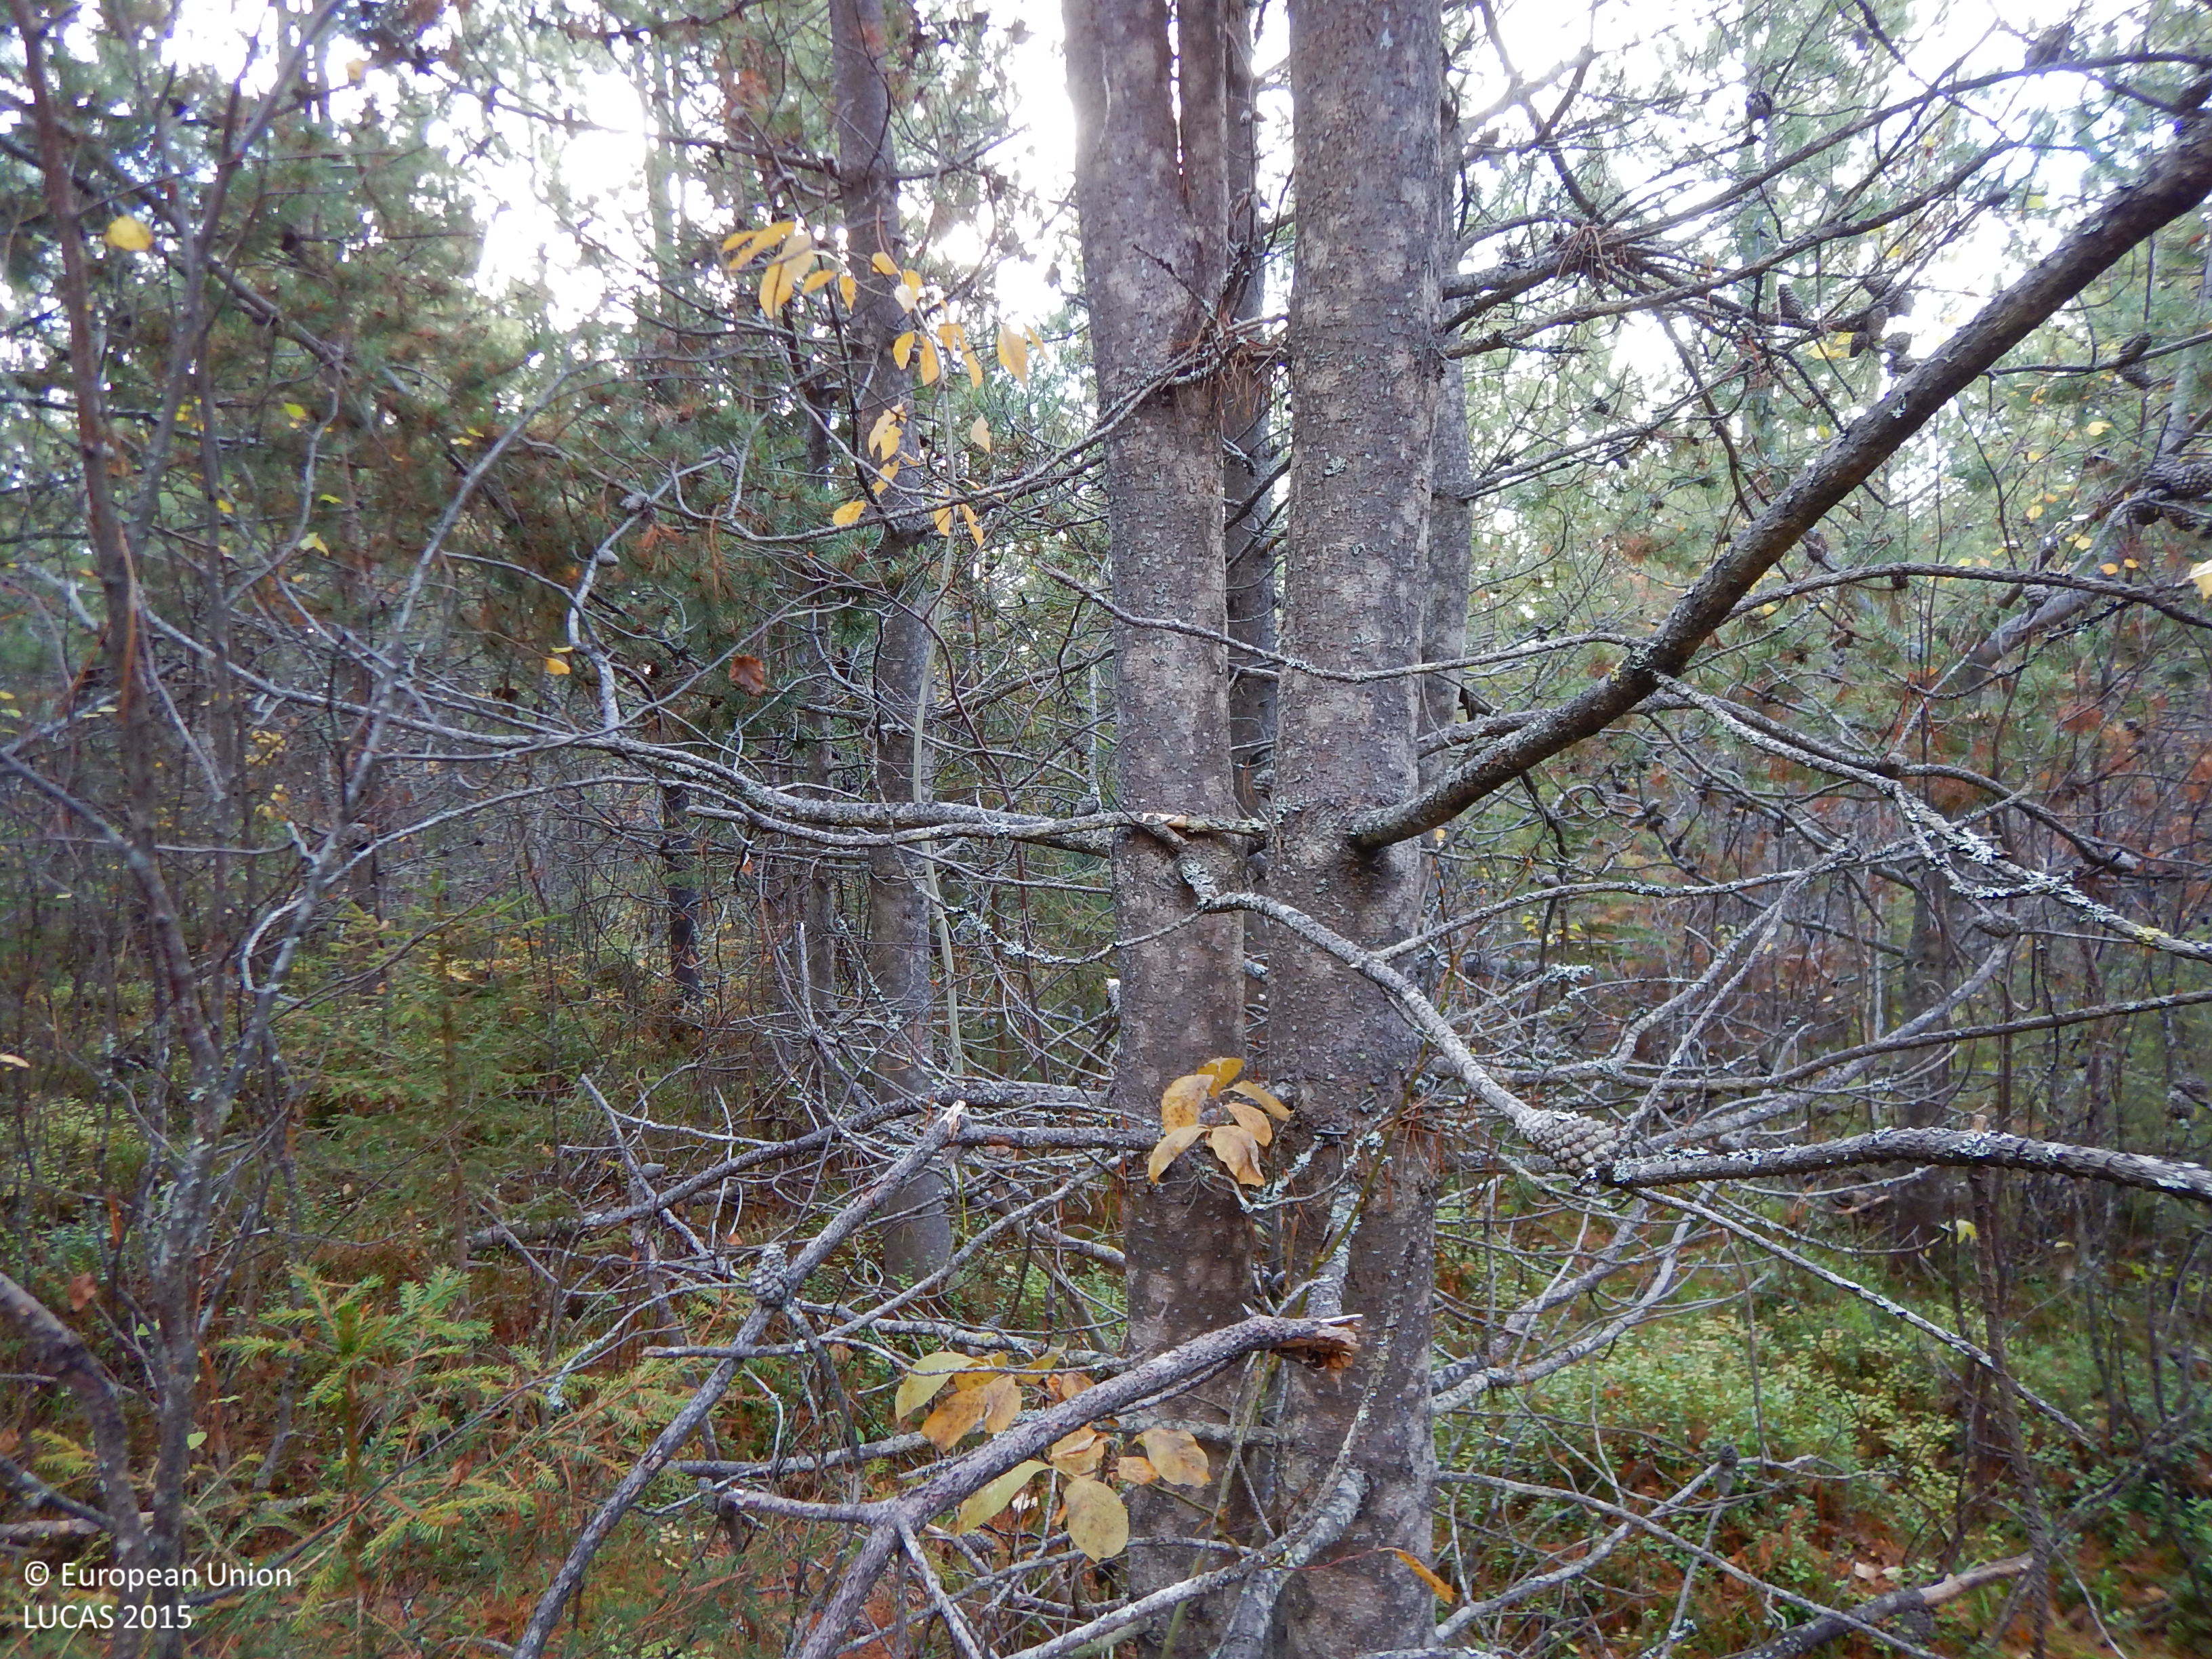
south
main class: Woodland
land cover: Pine dominated coniferous woodland
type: exotic forest
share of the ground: > 75 %
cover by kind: coniferous forest trees 75 %, shrubs 10 %, broadleaved forest trees 5 %, herbaceous plants 5 %, lichens and mosses 5 %
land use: Forestry
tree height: > 5 m
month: October
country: SE
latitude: 65.0868
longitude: 20.5456
